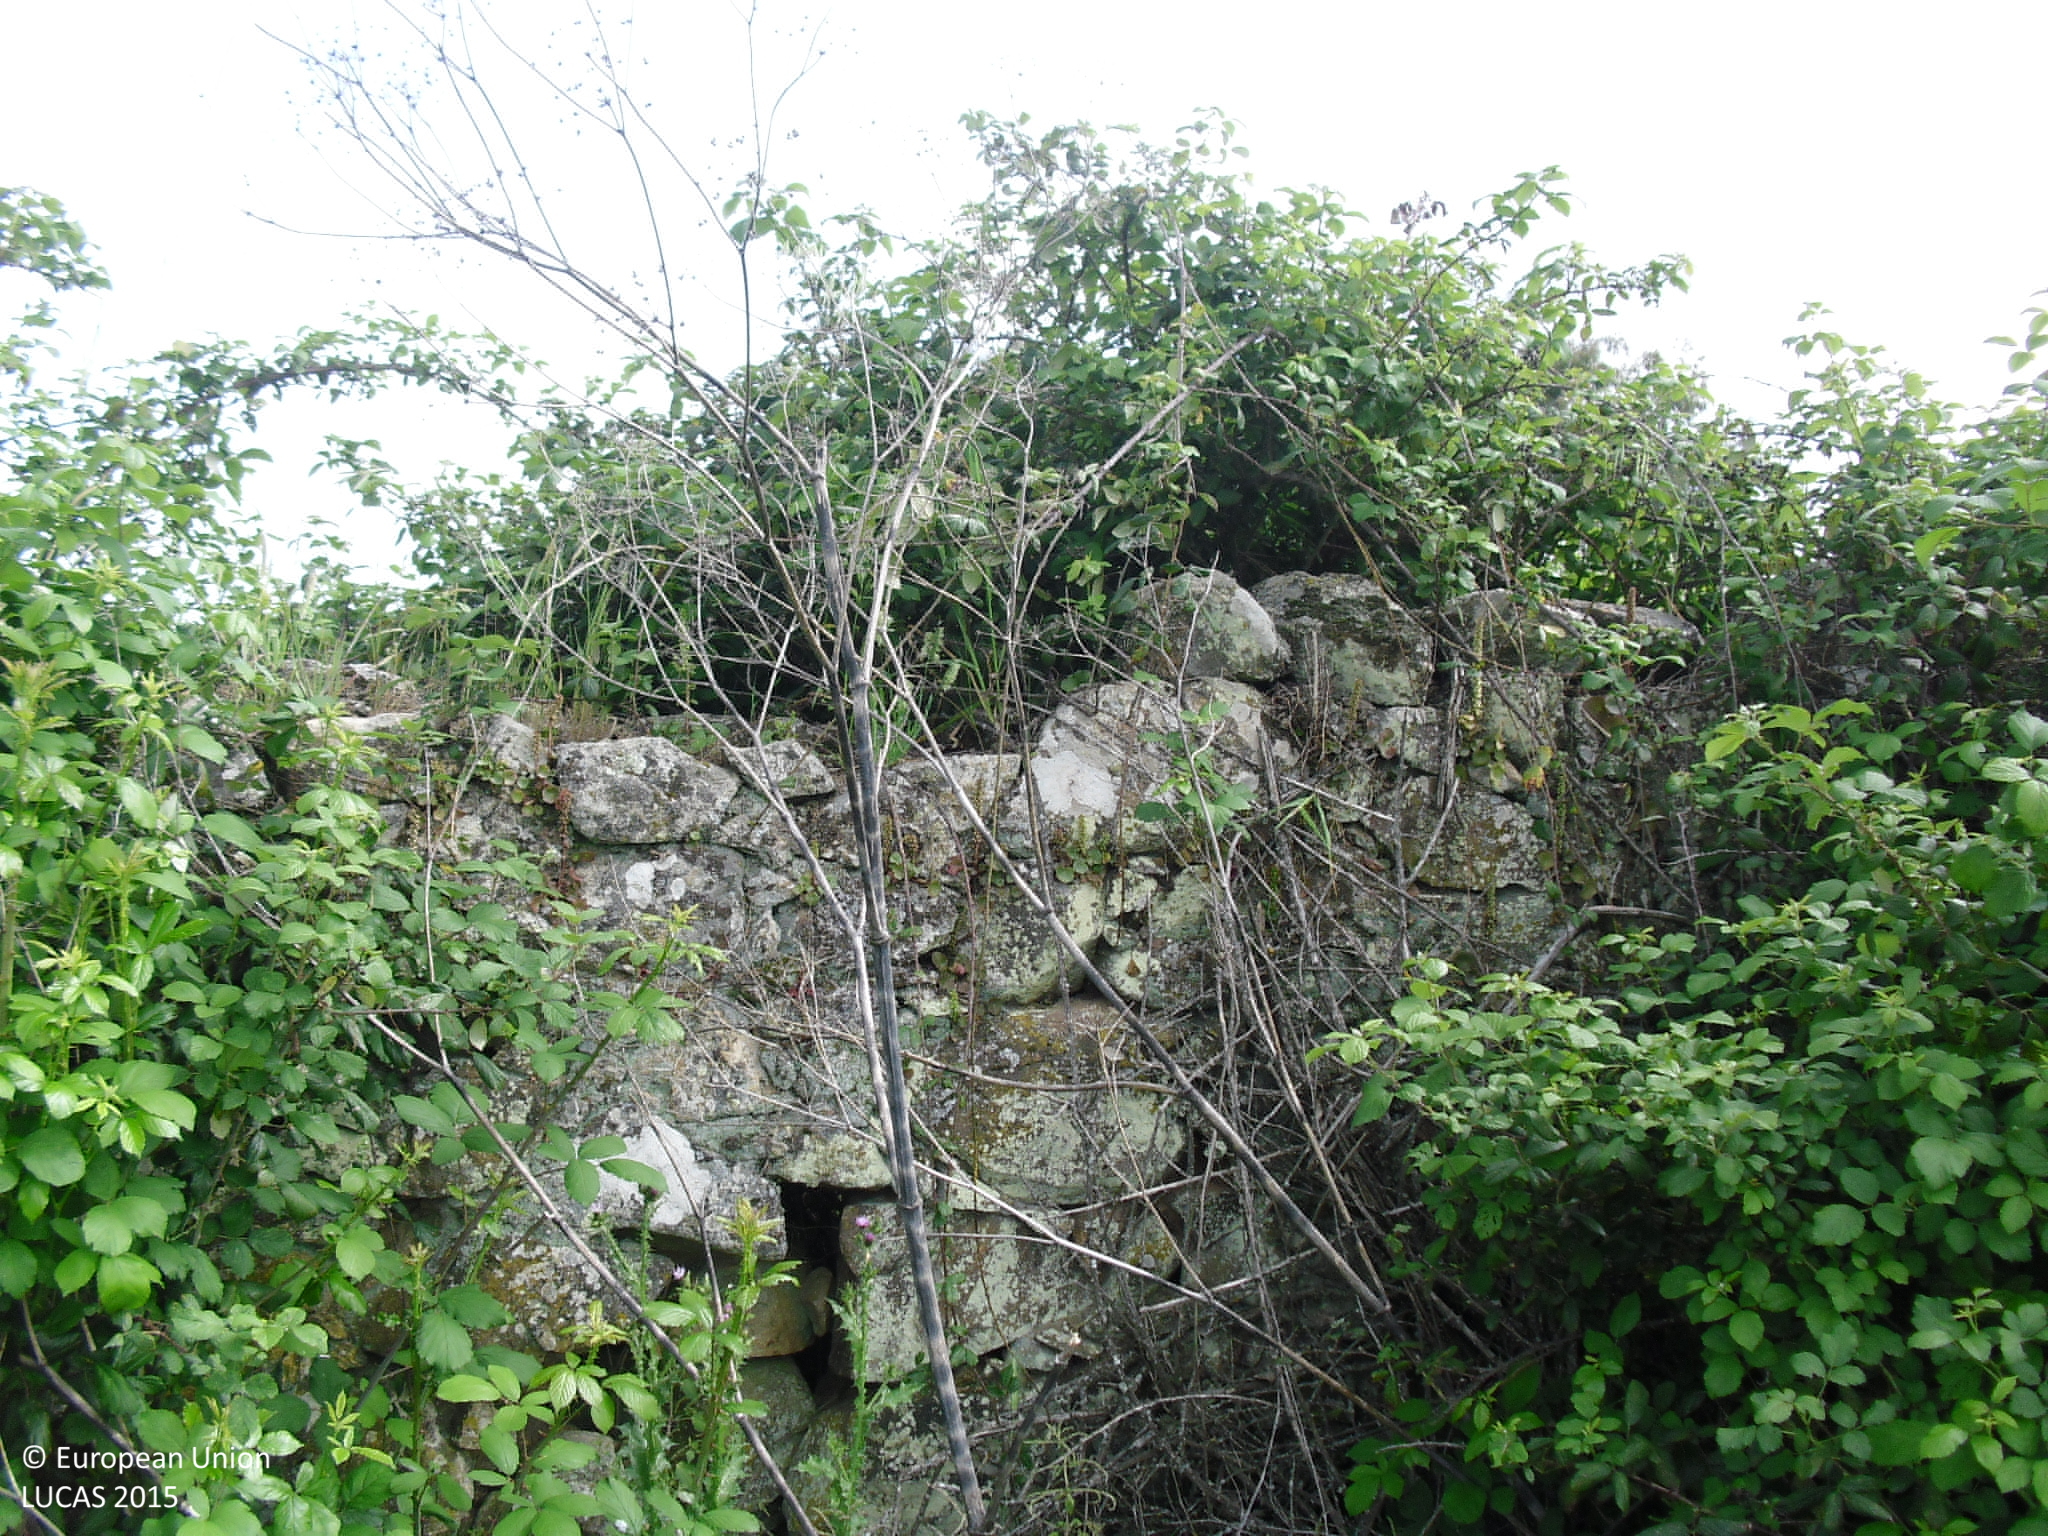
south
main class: Grassland
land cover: Grassland without tree/shrub cover
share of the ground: > 75 %
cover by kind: herbaceous plants 95 %, shrubs 5 %
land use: Agriculture (excluding fallow land and kitchen gardens)
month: April
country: ES
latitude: 39.3296
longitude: -6.0093
